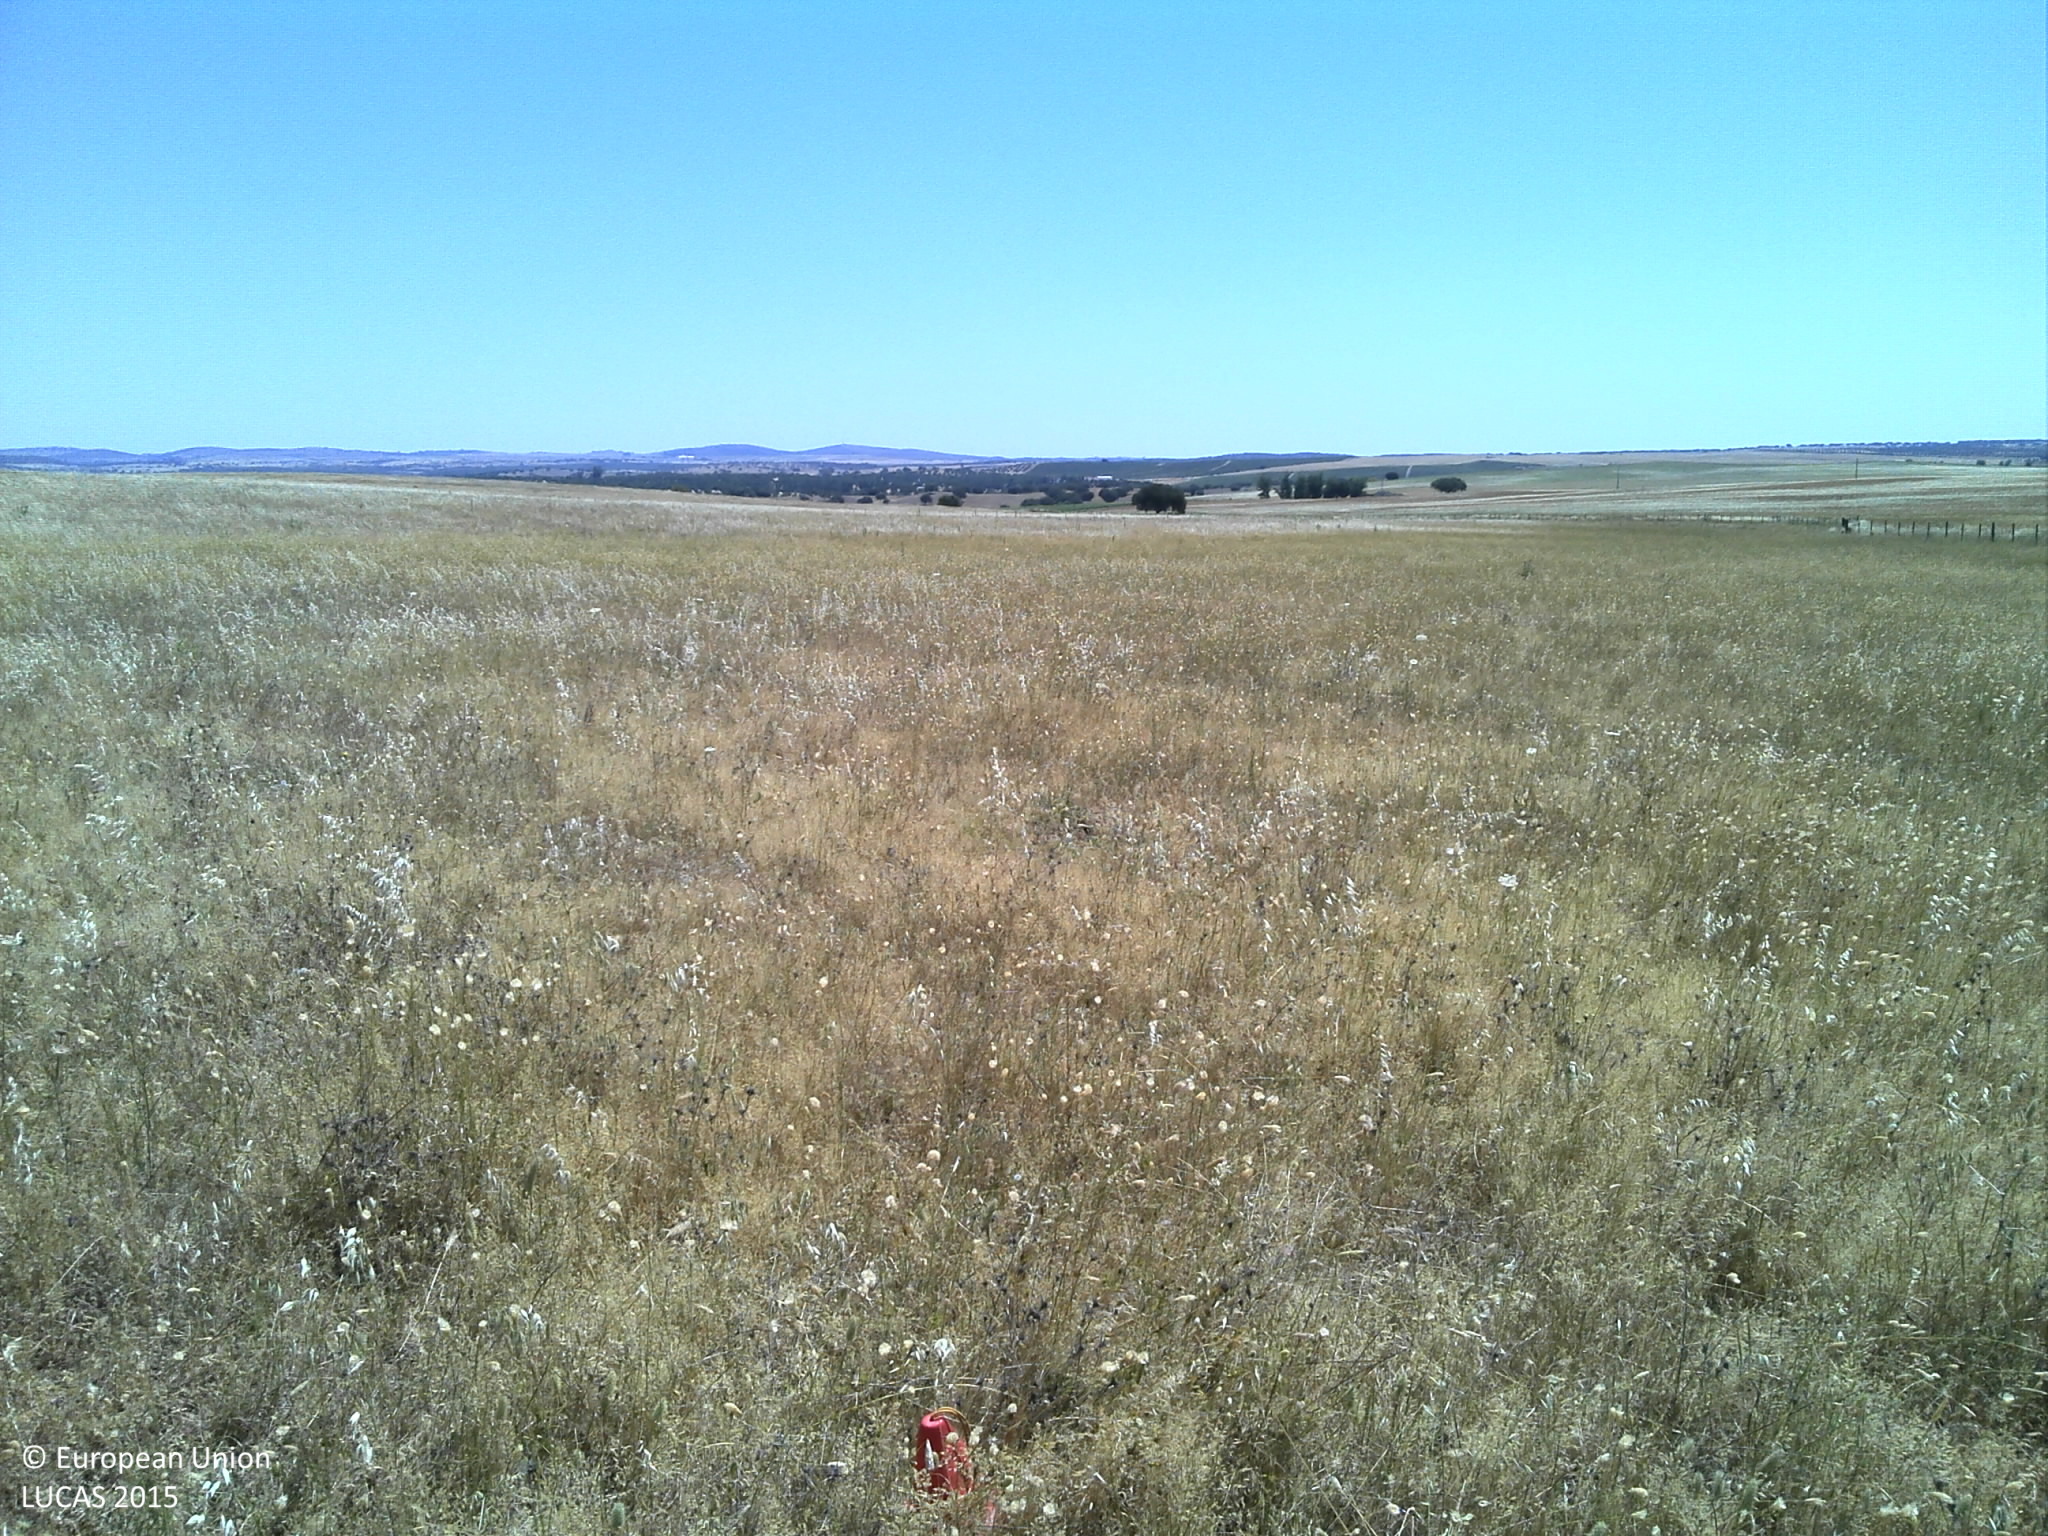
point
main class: Grassland
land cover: Grassland without tree/shrub cover
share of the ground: > 75 %
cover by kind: herbaceous plants 80 %, unconsolidated bare surface 20 %
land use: Agriculture (excluding fallow land and kitchen gardens)
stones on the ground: < 10 %
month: May
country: PT
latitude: 39.0295
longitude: -7.6107
